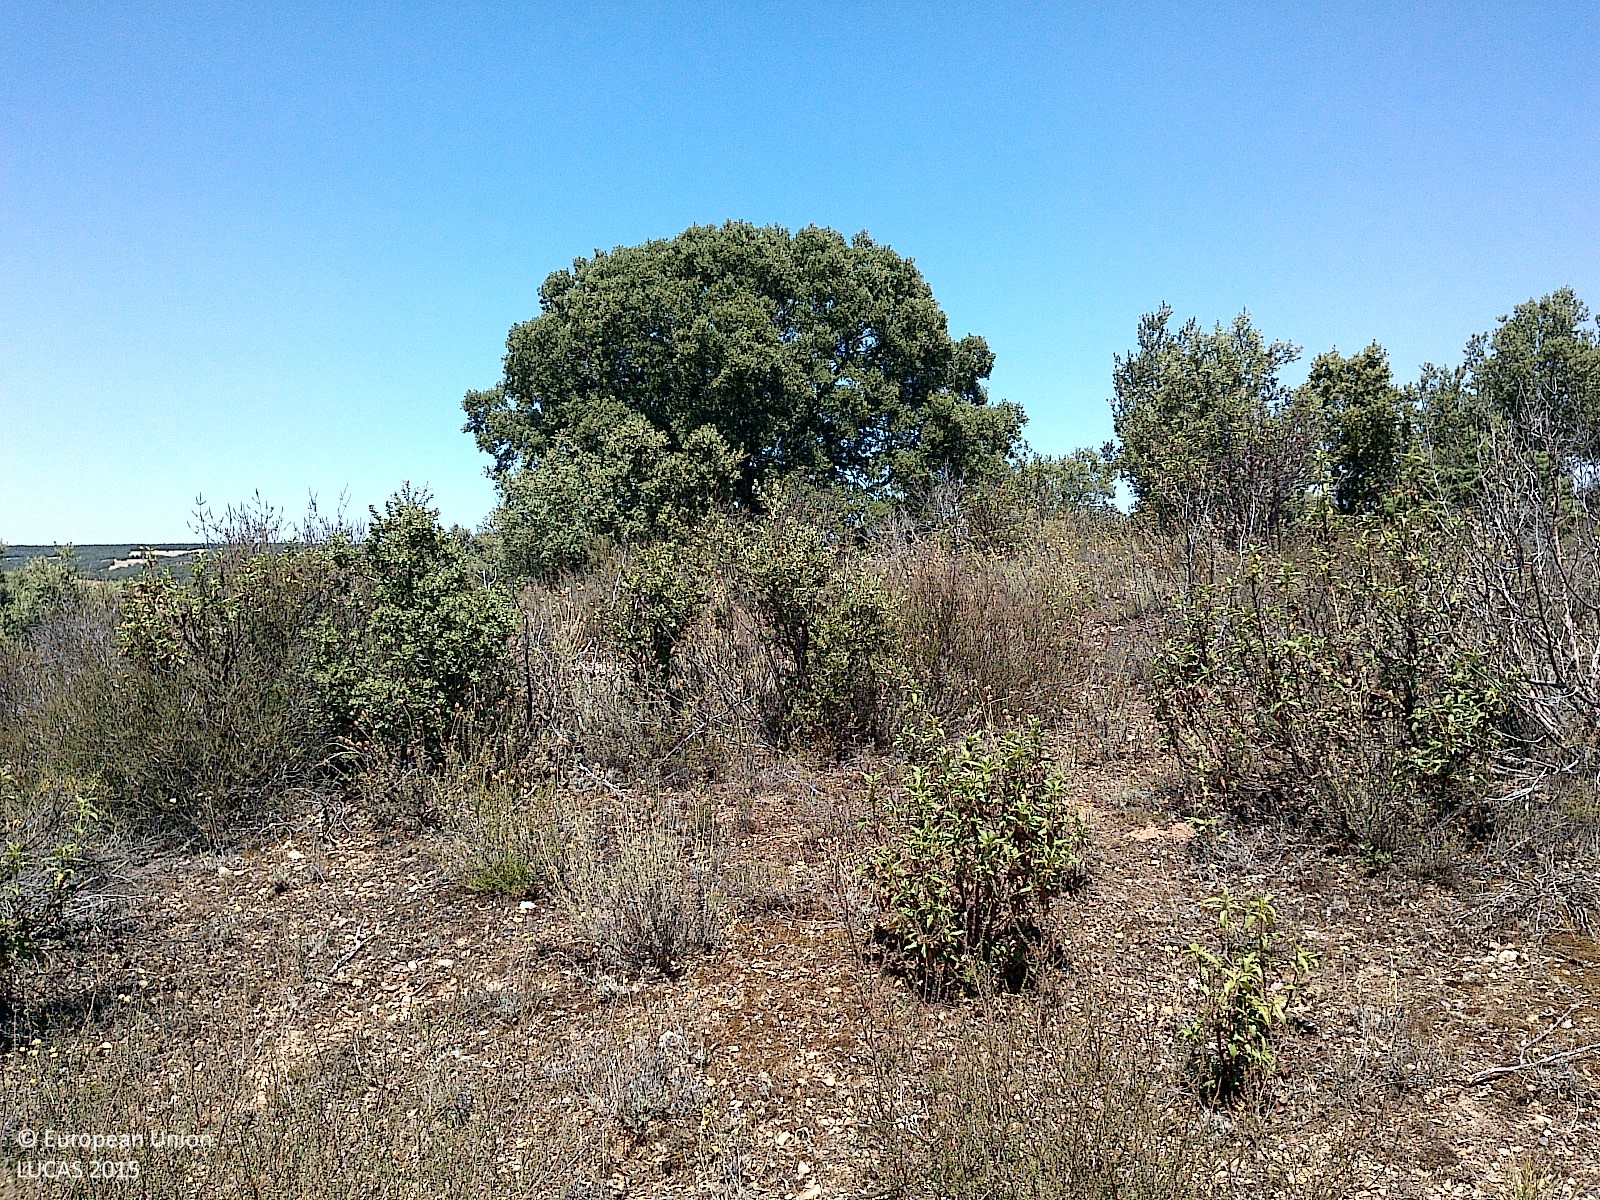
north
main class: Woodland
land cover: Broadleaved woodland
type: broadleaved evergreen forest
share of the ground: 25 - 50 %
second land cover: Grassland without tree/shrub cover
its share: > 75 %
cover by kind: shrubs 40 %, broadleaved forest trees 35 %, herbaceous plants 25 %
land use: Forestry
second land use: Agriculture (excluding fallow land and kitchen gardens)
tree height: < 5 m
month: July
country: ES
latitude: 41.6649
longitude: -3.1481
